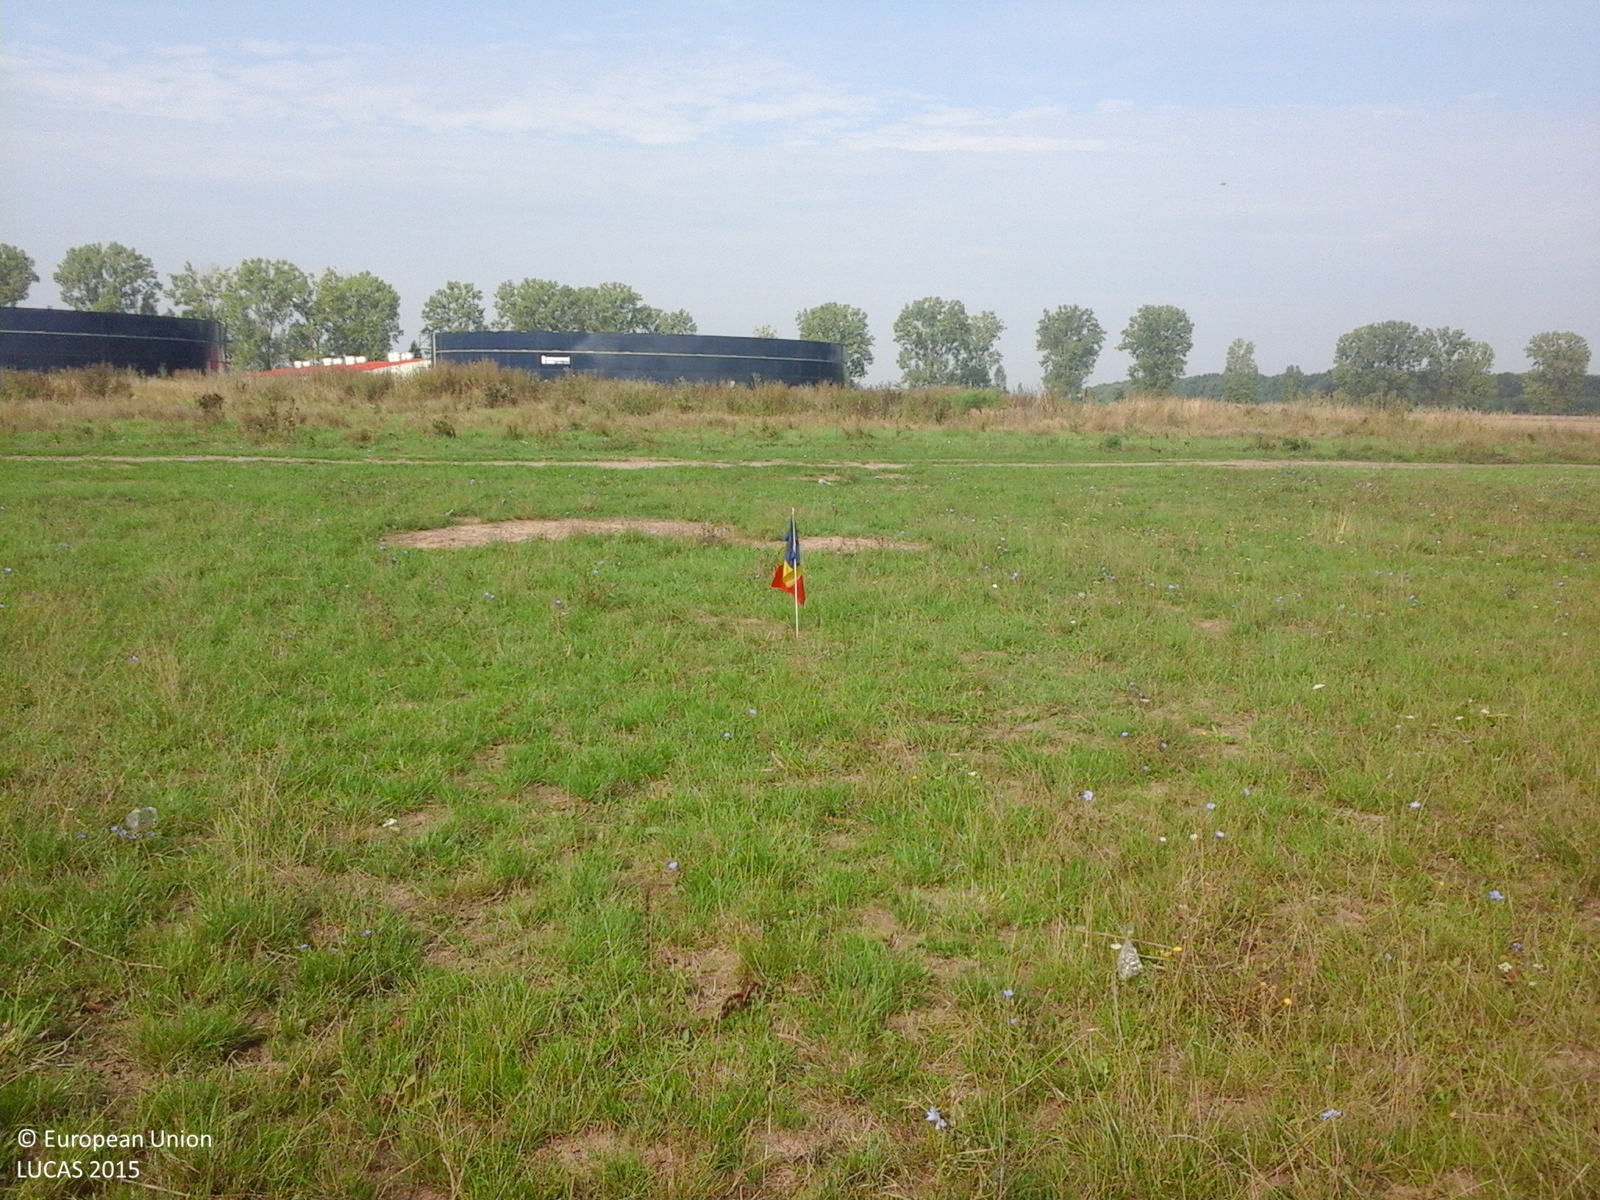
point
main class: Grassland
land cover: Grassland without tree/shrub cover
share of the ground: > 75 %
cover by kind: herbaceous plants 100 %
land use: Agriculture (excluding fallow land and kitchen gardens)
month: August
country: RO
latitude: 46.5506
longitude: 21.6344
